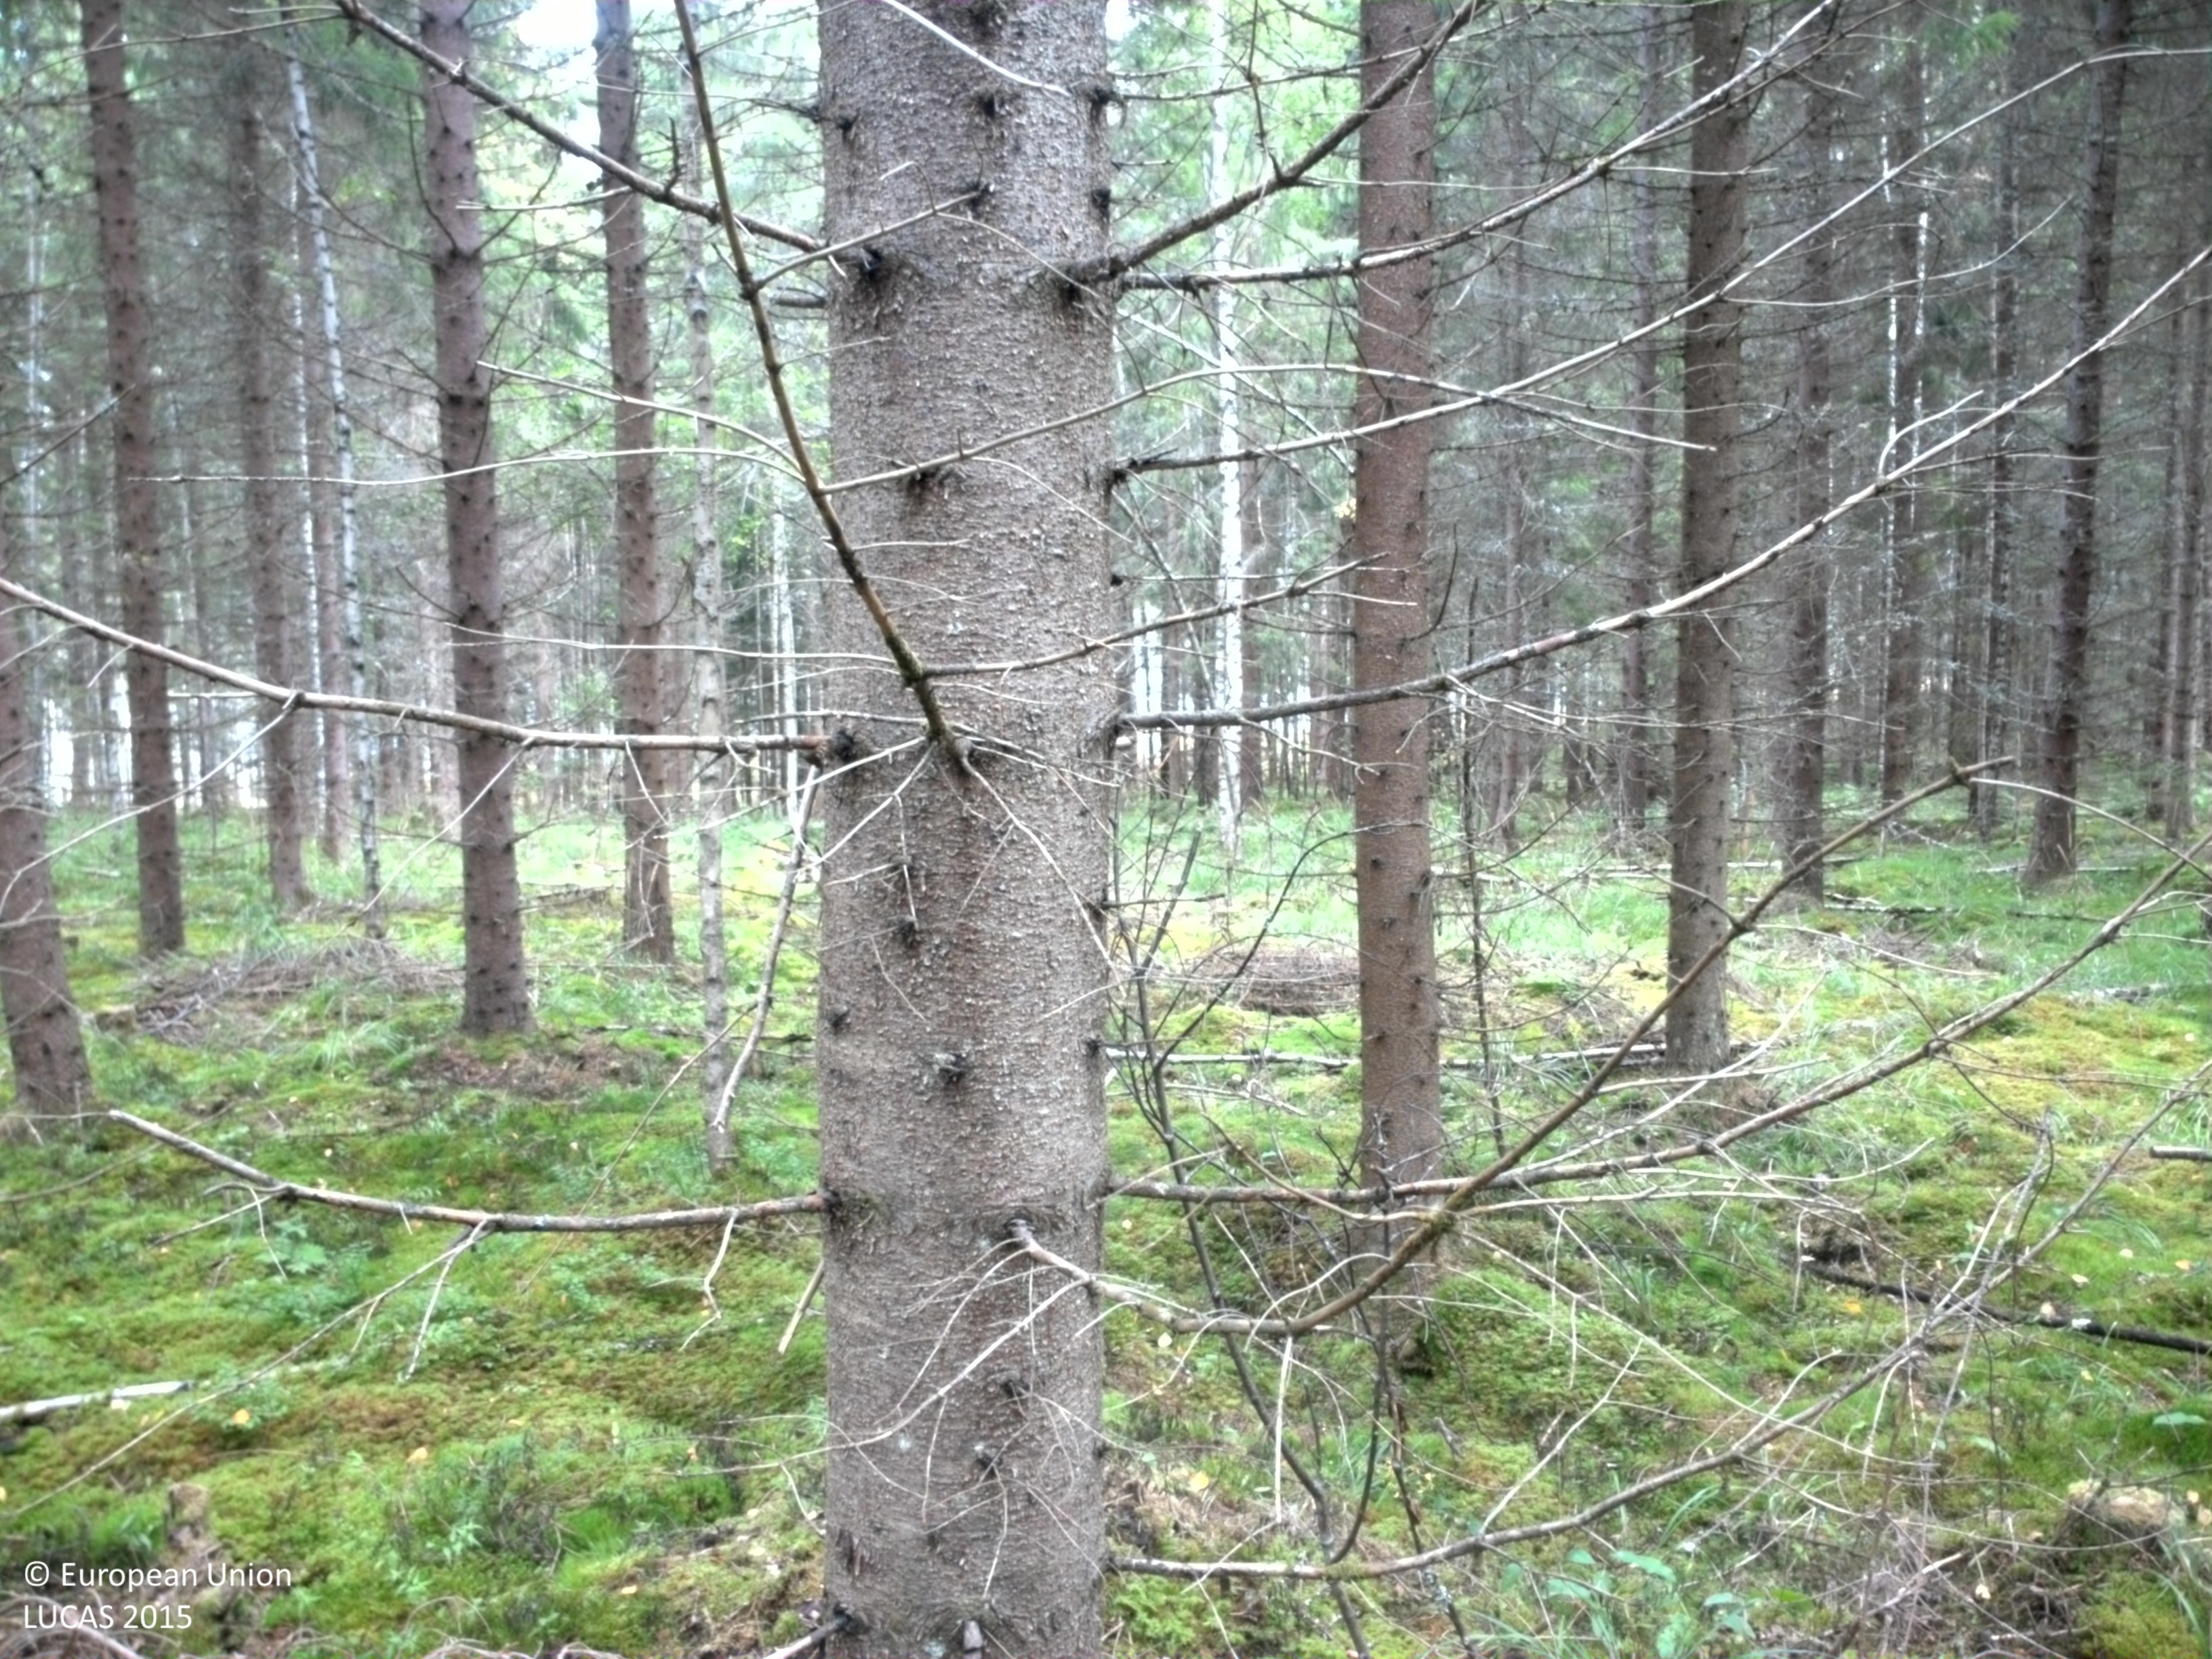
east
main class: Woodland
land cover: Spruce dominated coniferous woodland
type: boreal forest
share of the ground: 50 - 75 %
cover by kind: coniferous forest trees 65 %, lichens and mosses 20 %, broadleaved forest trees 5 %, shrubs 5 %, herbaceous plants 5 %
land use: Forestry
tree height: > 5 m
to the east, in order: Spruce dominated coniferous woodland; Tracks; Spruce dominated coniferous woodland; Shrubland with sparse tree cover; Tracks; Broadleaved woodland; Shrubland with sparse tree cover; Broadleaved woodland; Ditches and canals; Grass margins; Tracks
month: August
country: SE
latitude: 59.6717
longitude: 13.3828
